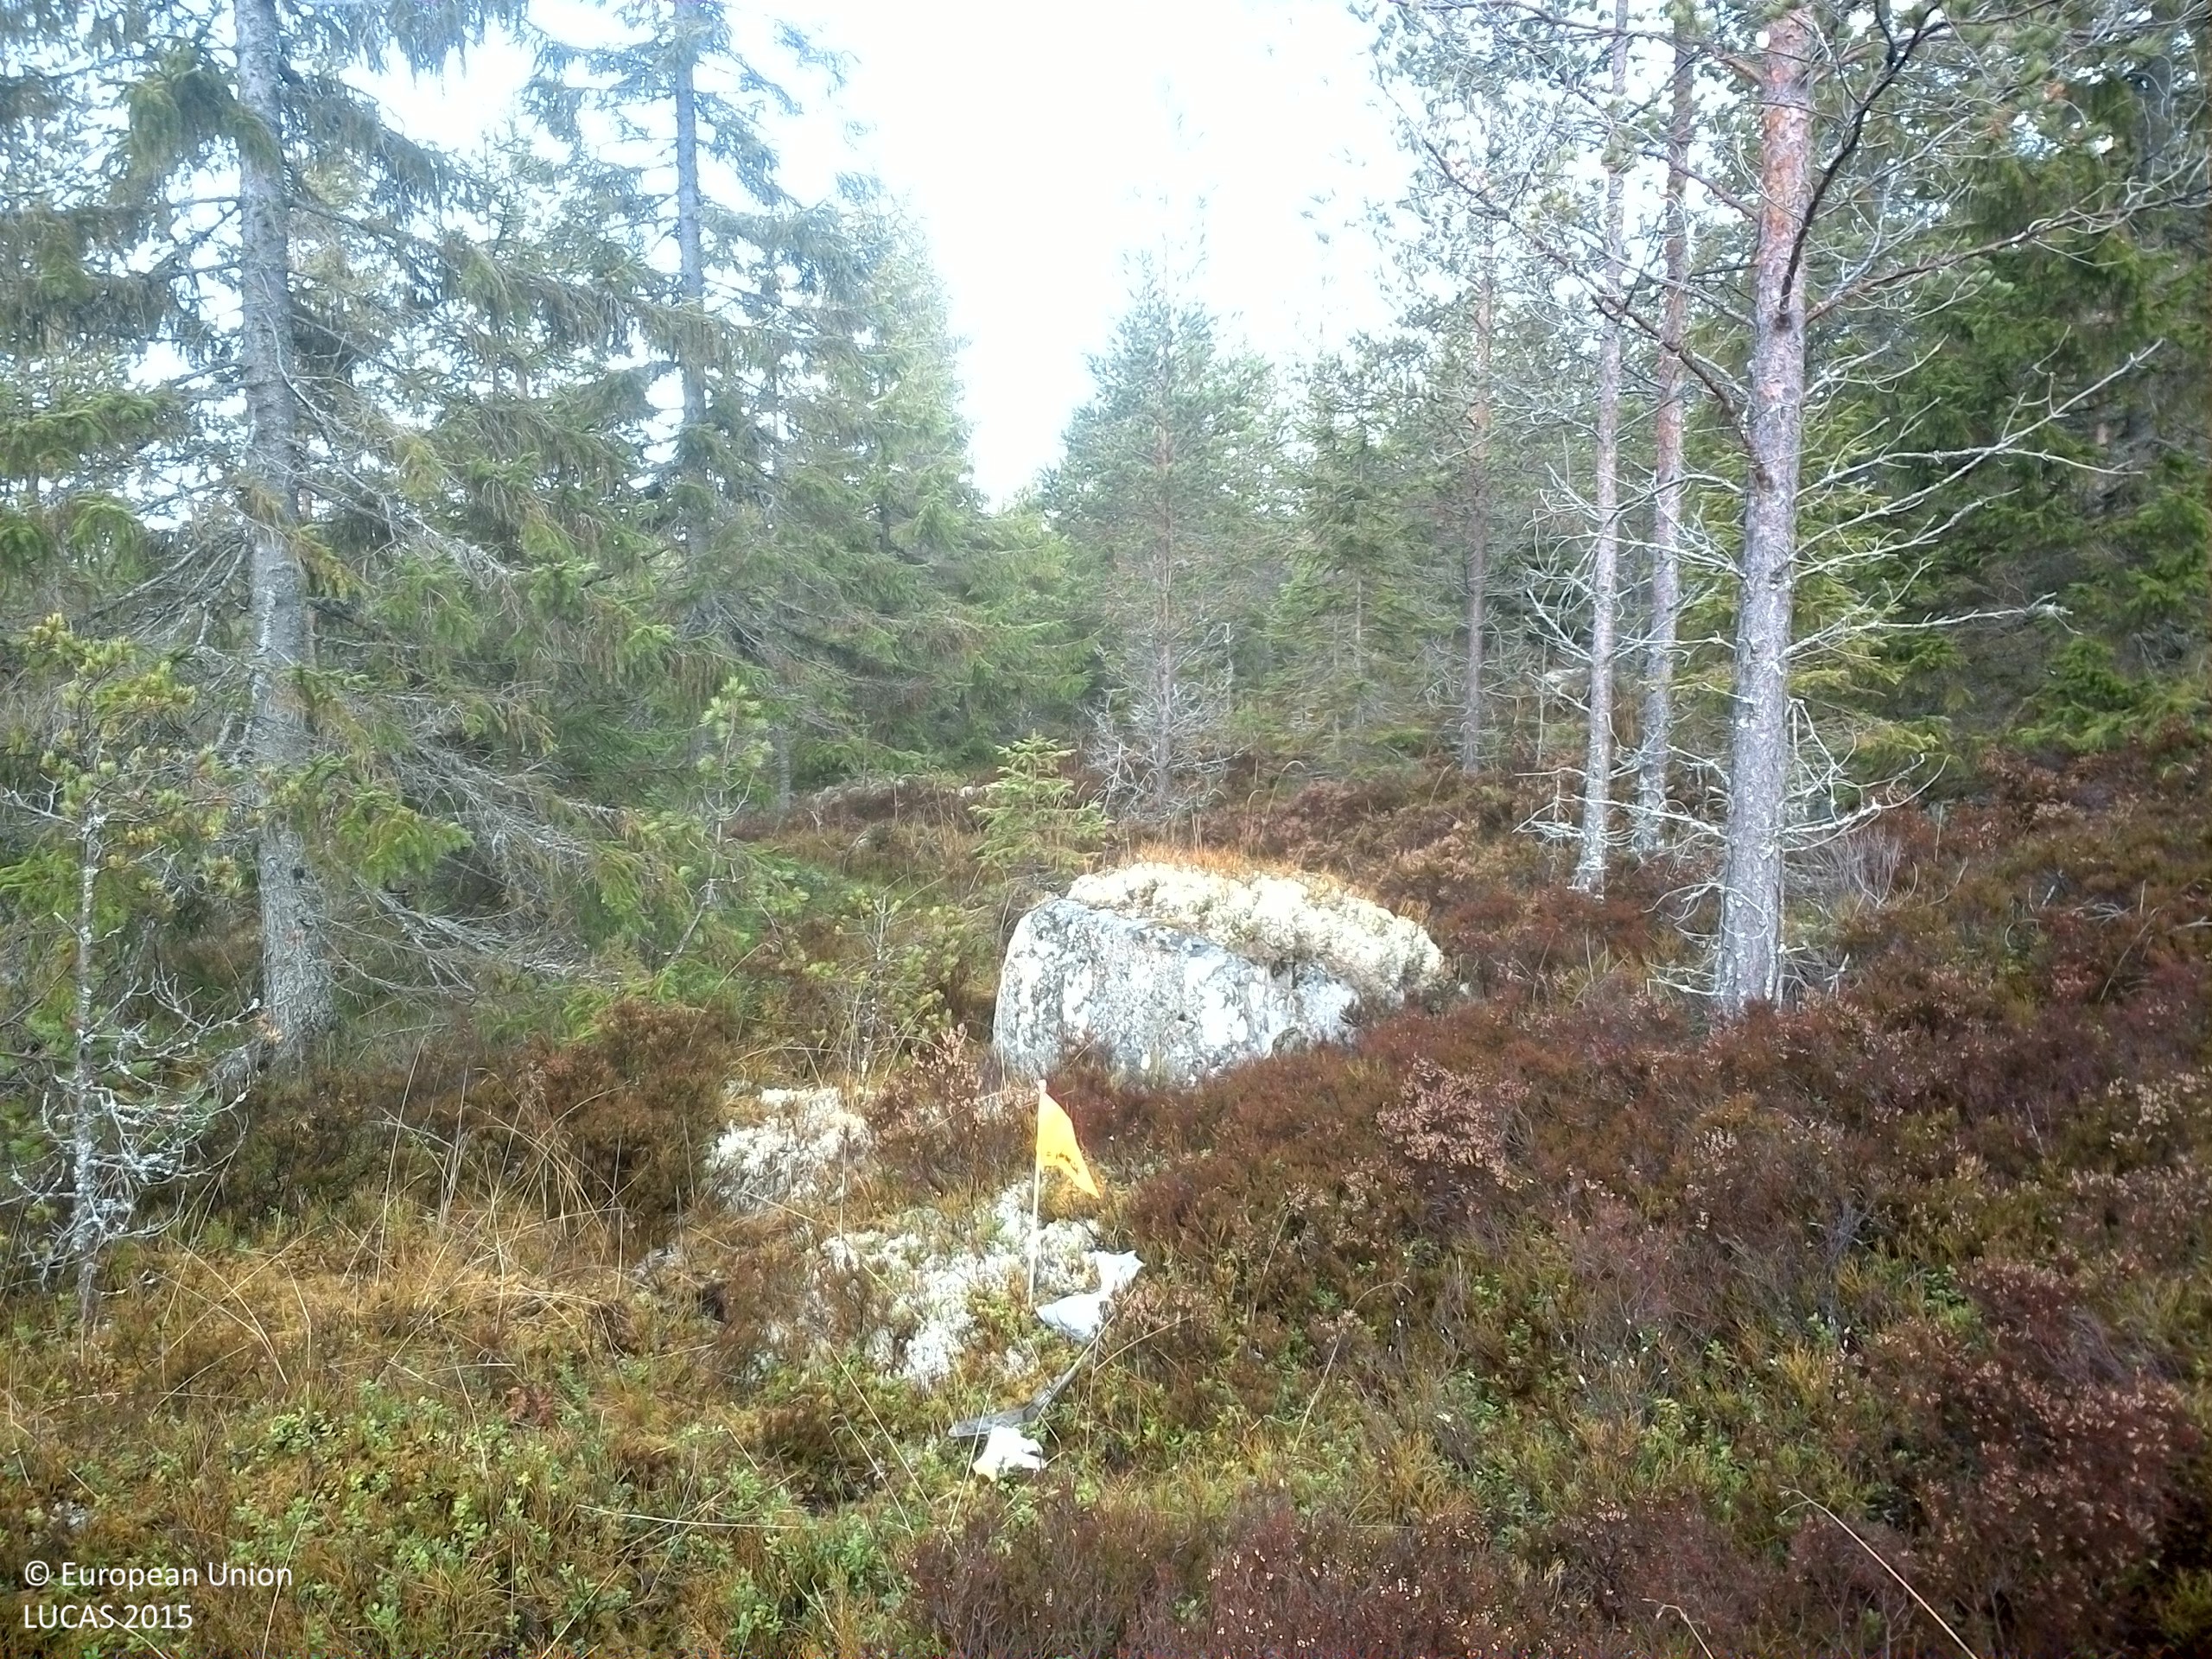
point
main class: Woodland
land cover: Other coniferous woodland
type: boreal forest
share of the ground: 25 - 50 %
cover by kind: coniferous forest trees 45 %, shrubs 40 %, lichens and mosses 10 %, herbaceous plants 5 %
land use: Forestry
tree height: > 5 m
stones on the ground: 10 - 25 %
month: November
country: SE
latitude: 60.2621
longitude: 14.7781
